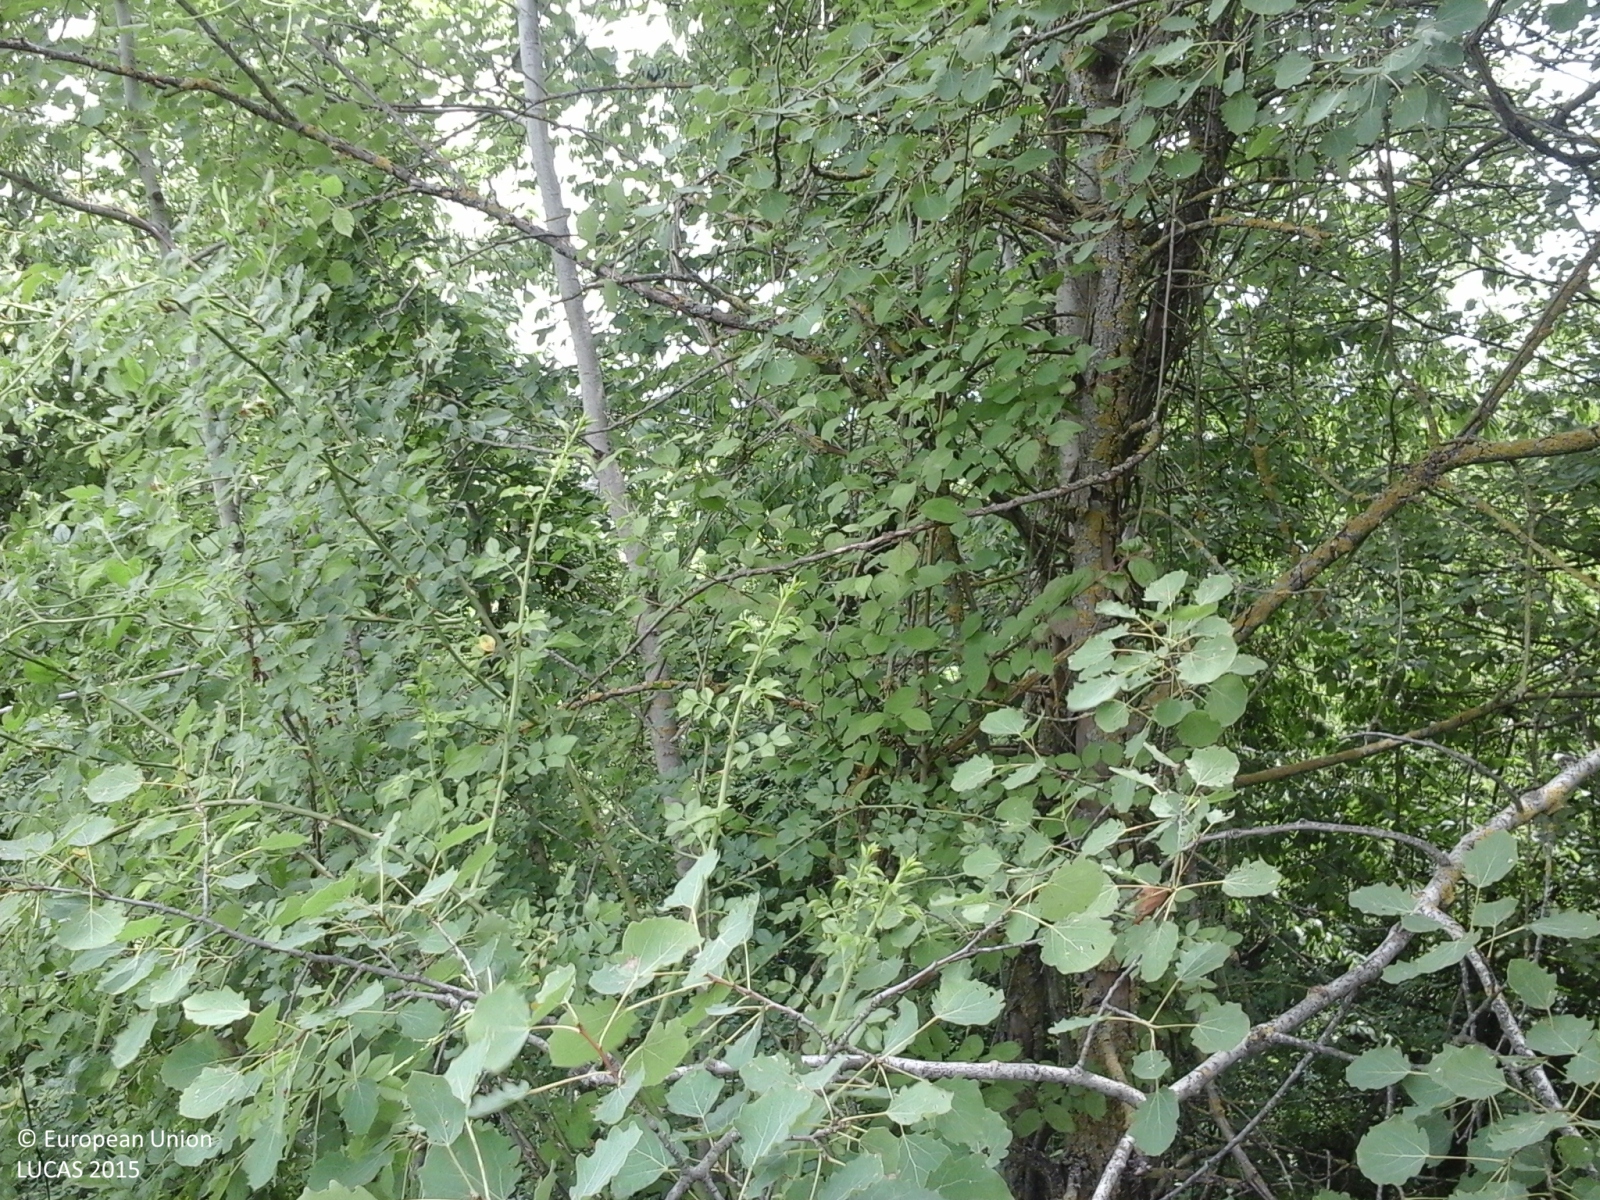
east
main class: Woodland
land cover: Broadleaved woodland
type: thermophilous deciduous forest
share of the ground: > 75 %
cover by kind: broadleaved forest trees 90 %, shrubs 5 %, herbaceous plants 5 %
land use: Semi-natural and natural areas not in use
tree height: > 5 m
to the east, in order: Broadleaved woodland; Shrubland with sparse tree cover; Tracks; Broadleaved woodland; Nuts trees; Grassland without tree/shrub cover
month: June
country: IT
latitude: 44.5668
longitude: 8.0524
